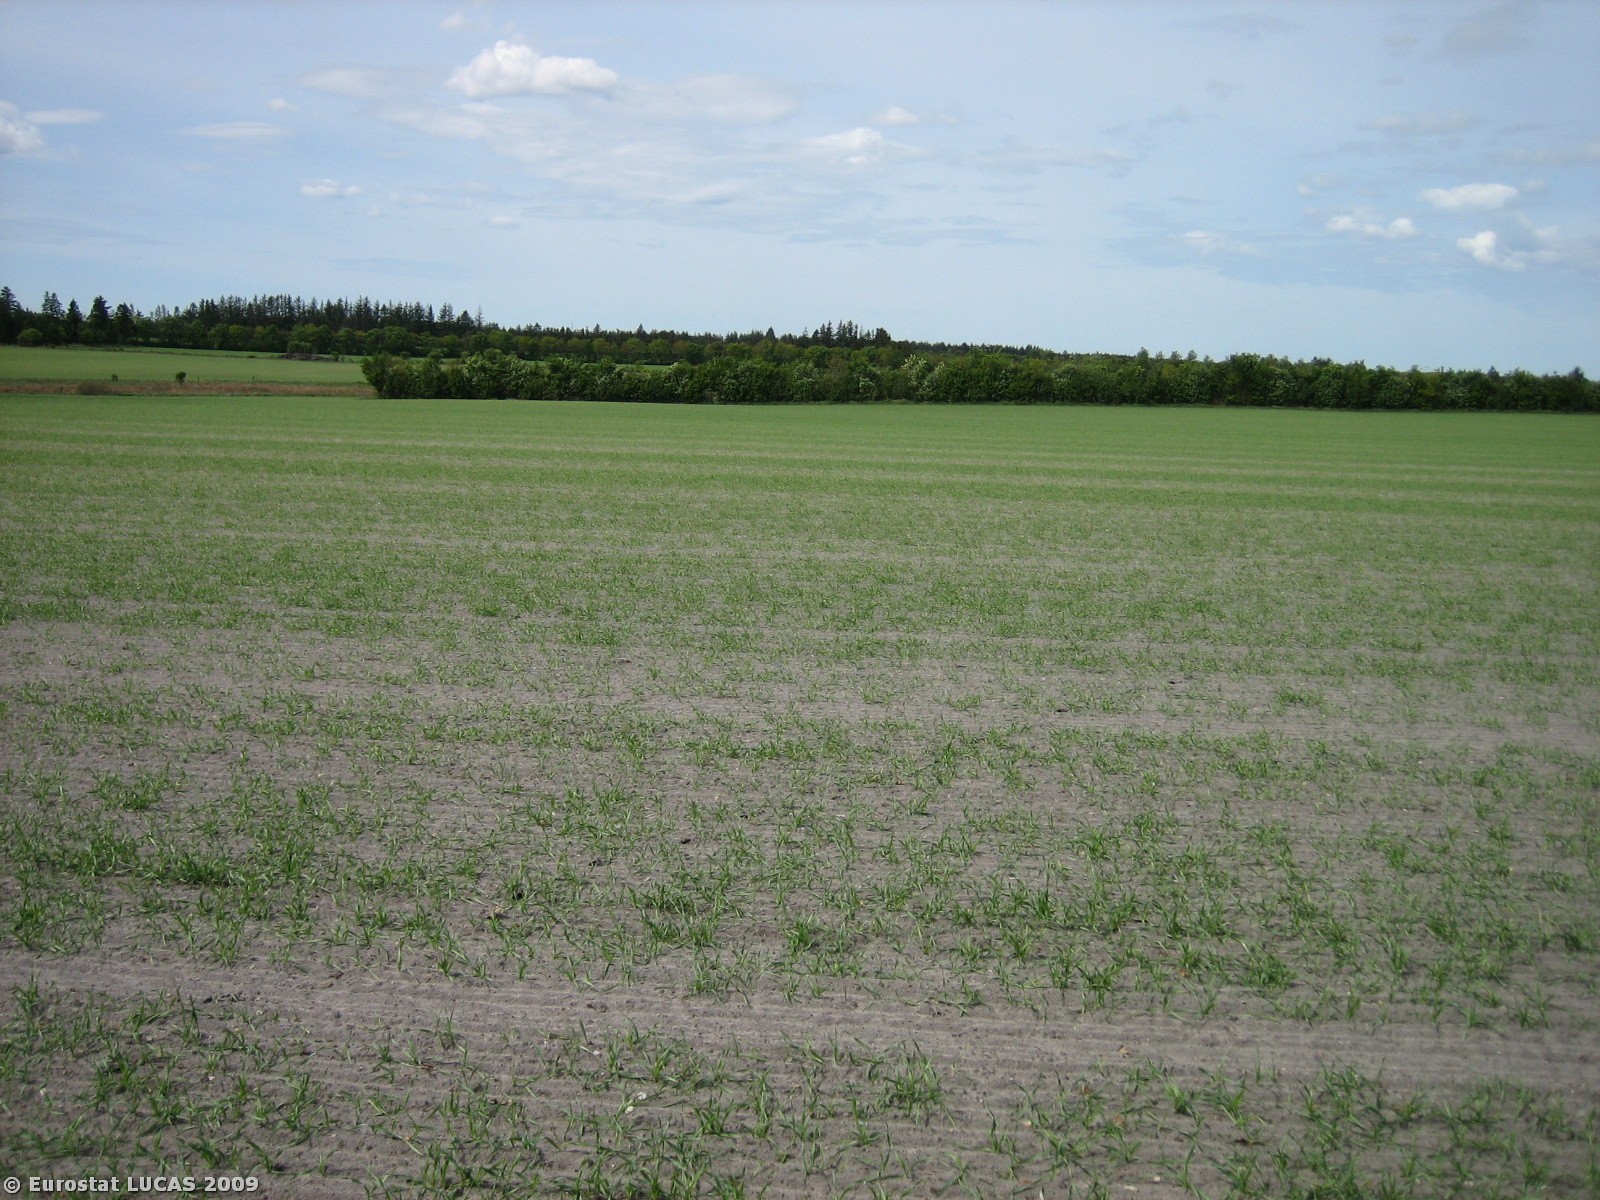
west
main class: Shrubland
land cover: Shrubland with sparse tree cover
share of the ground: > 75 %
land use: Unused
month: May
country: DK
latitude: 56.1958
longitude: 8.4062
